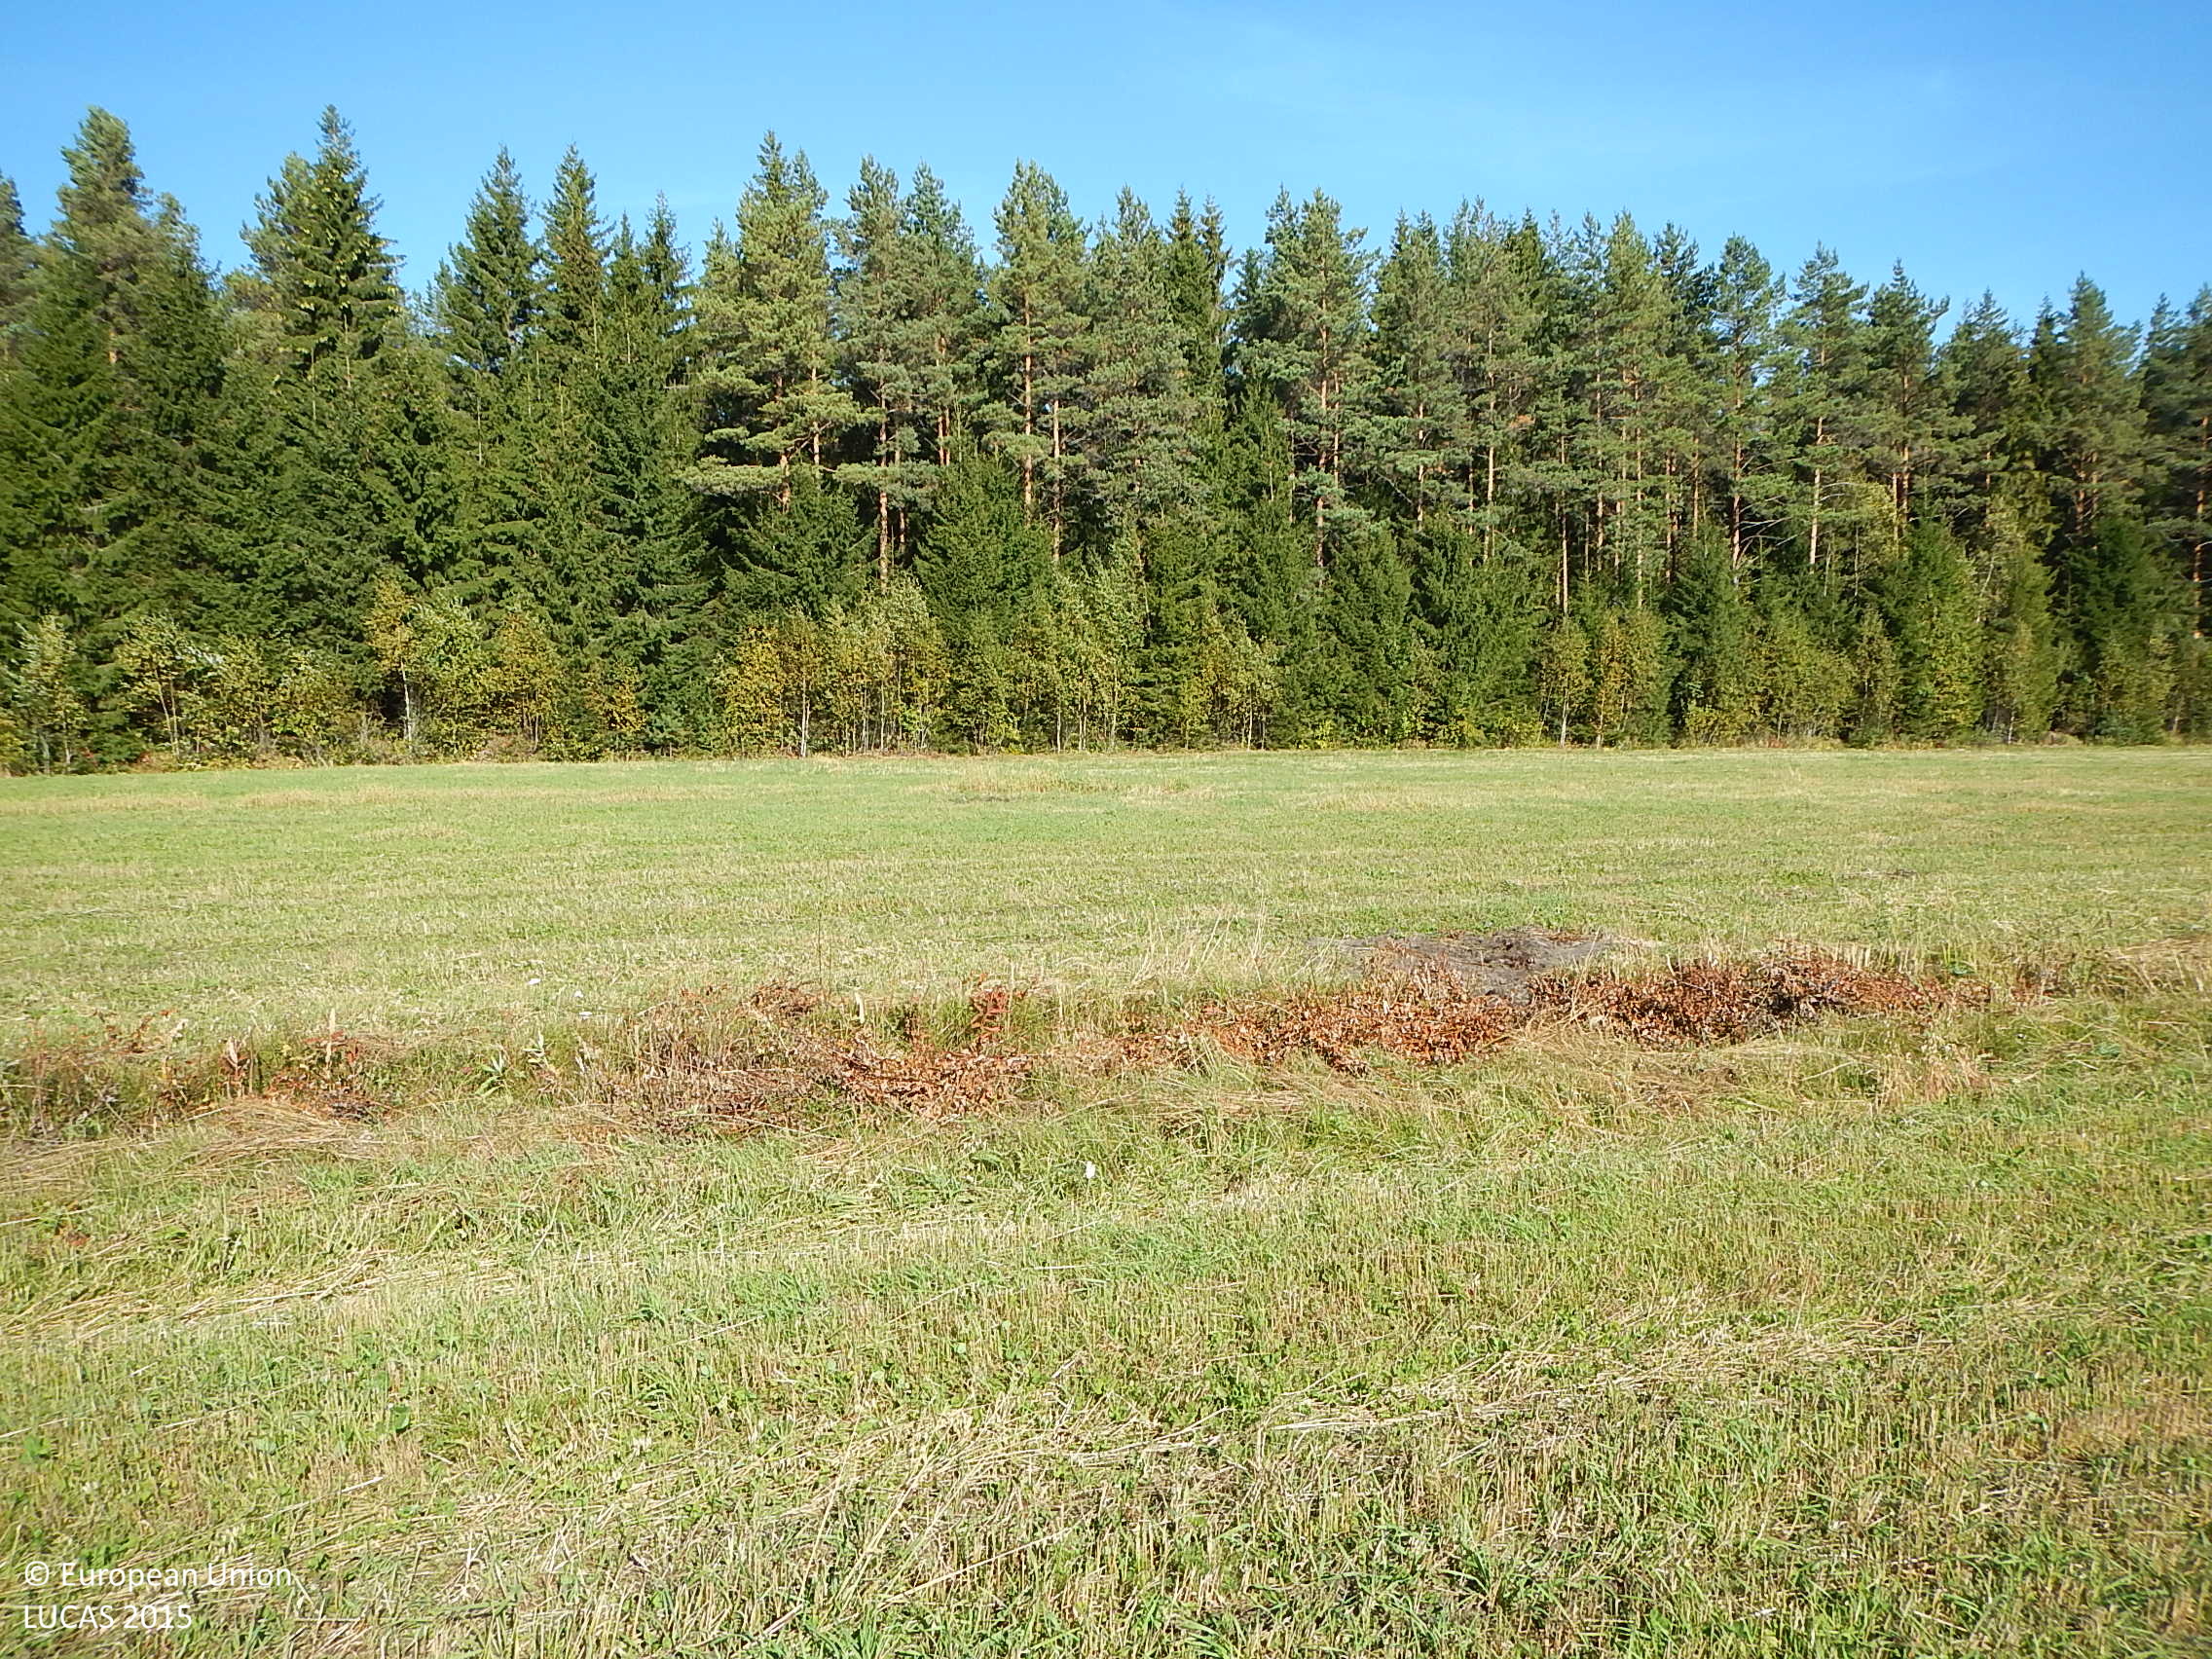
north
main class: Cropland
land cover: Oats
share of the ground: > 75 %
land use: Agriculture (excluding fallow land and kitchen gardens)
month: September
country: FI
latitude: 61.9864
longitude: 21.5175
